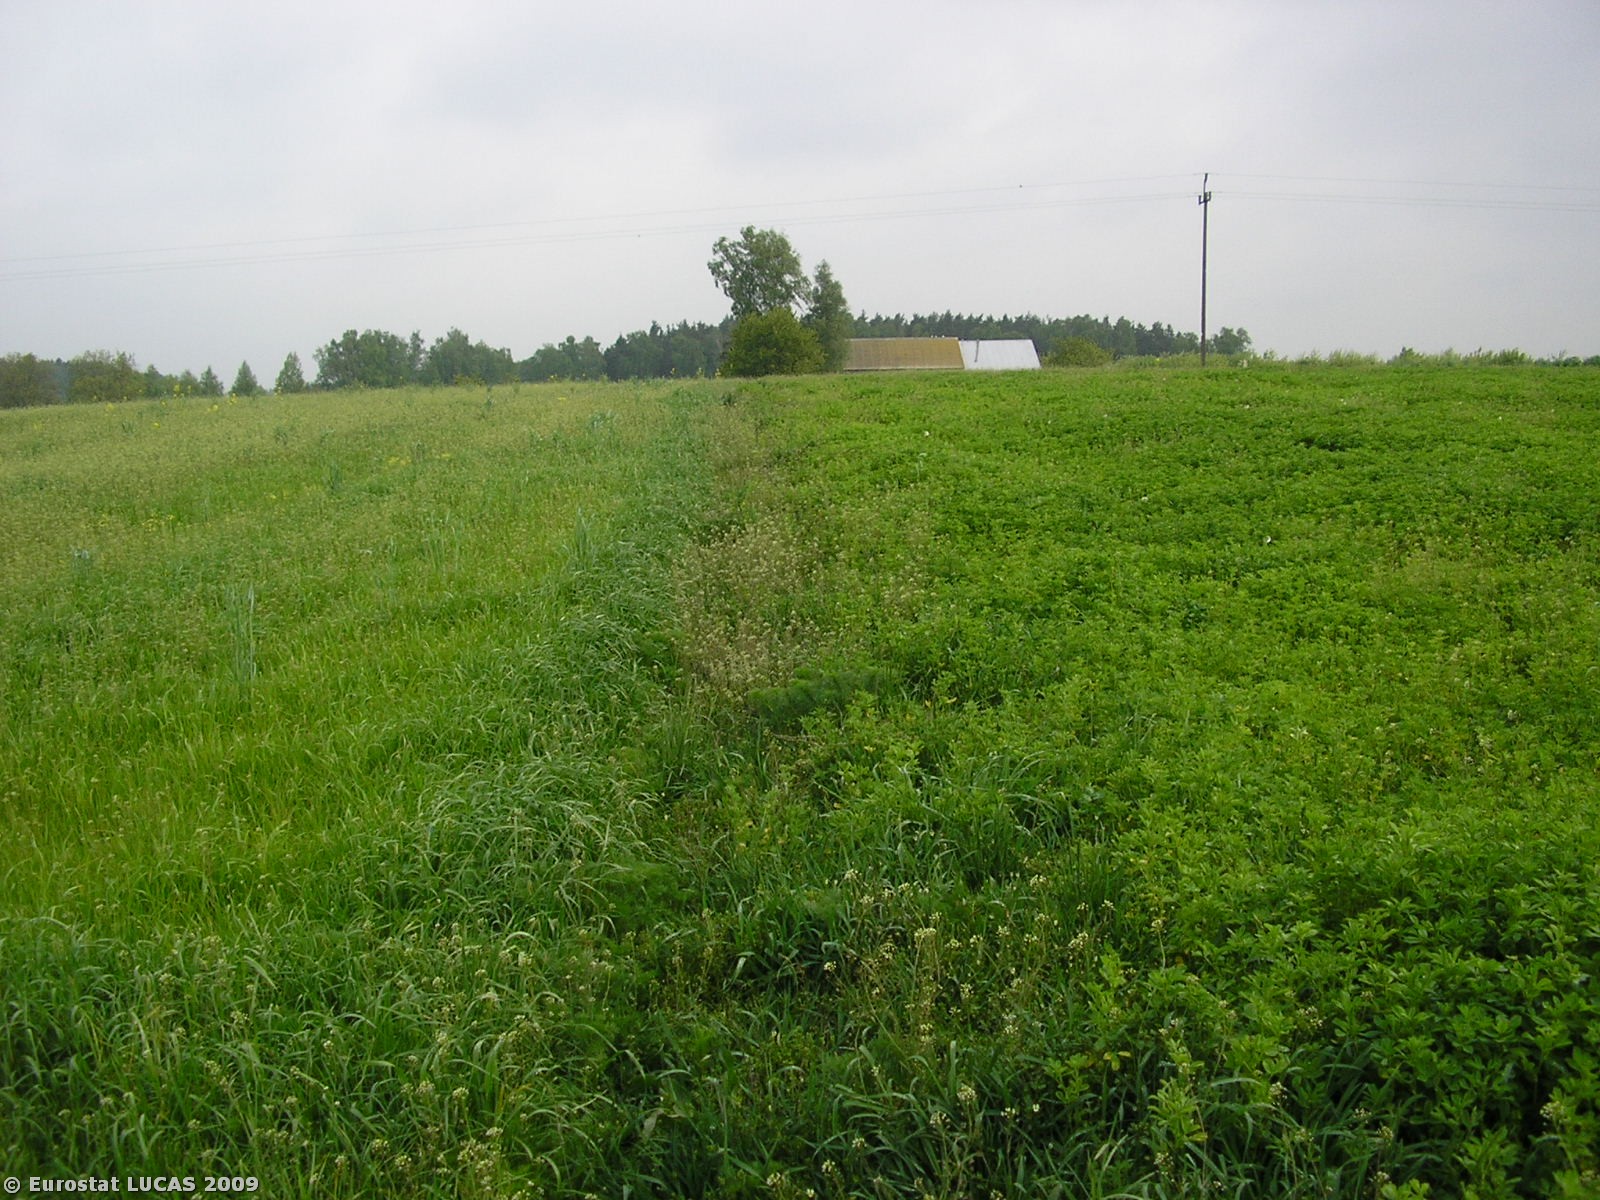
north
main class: Cropland
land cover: Lucerne
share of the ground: > 75 %
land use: Agriculture (excluding fallow land and kitchen gardens)
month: June
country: PL
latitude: 52.4901
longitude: 20.3009
